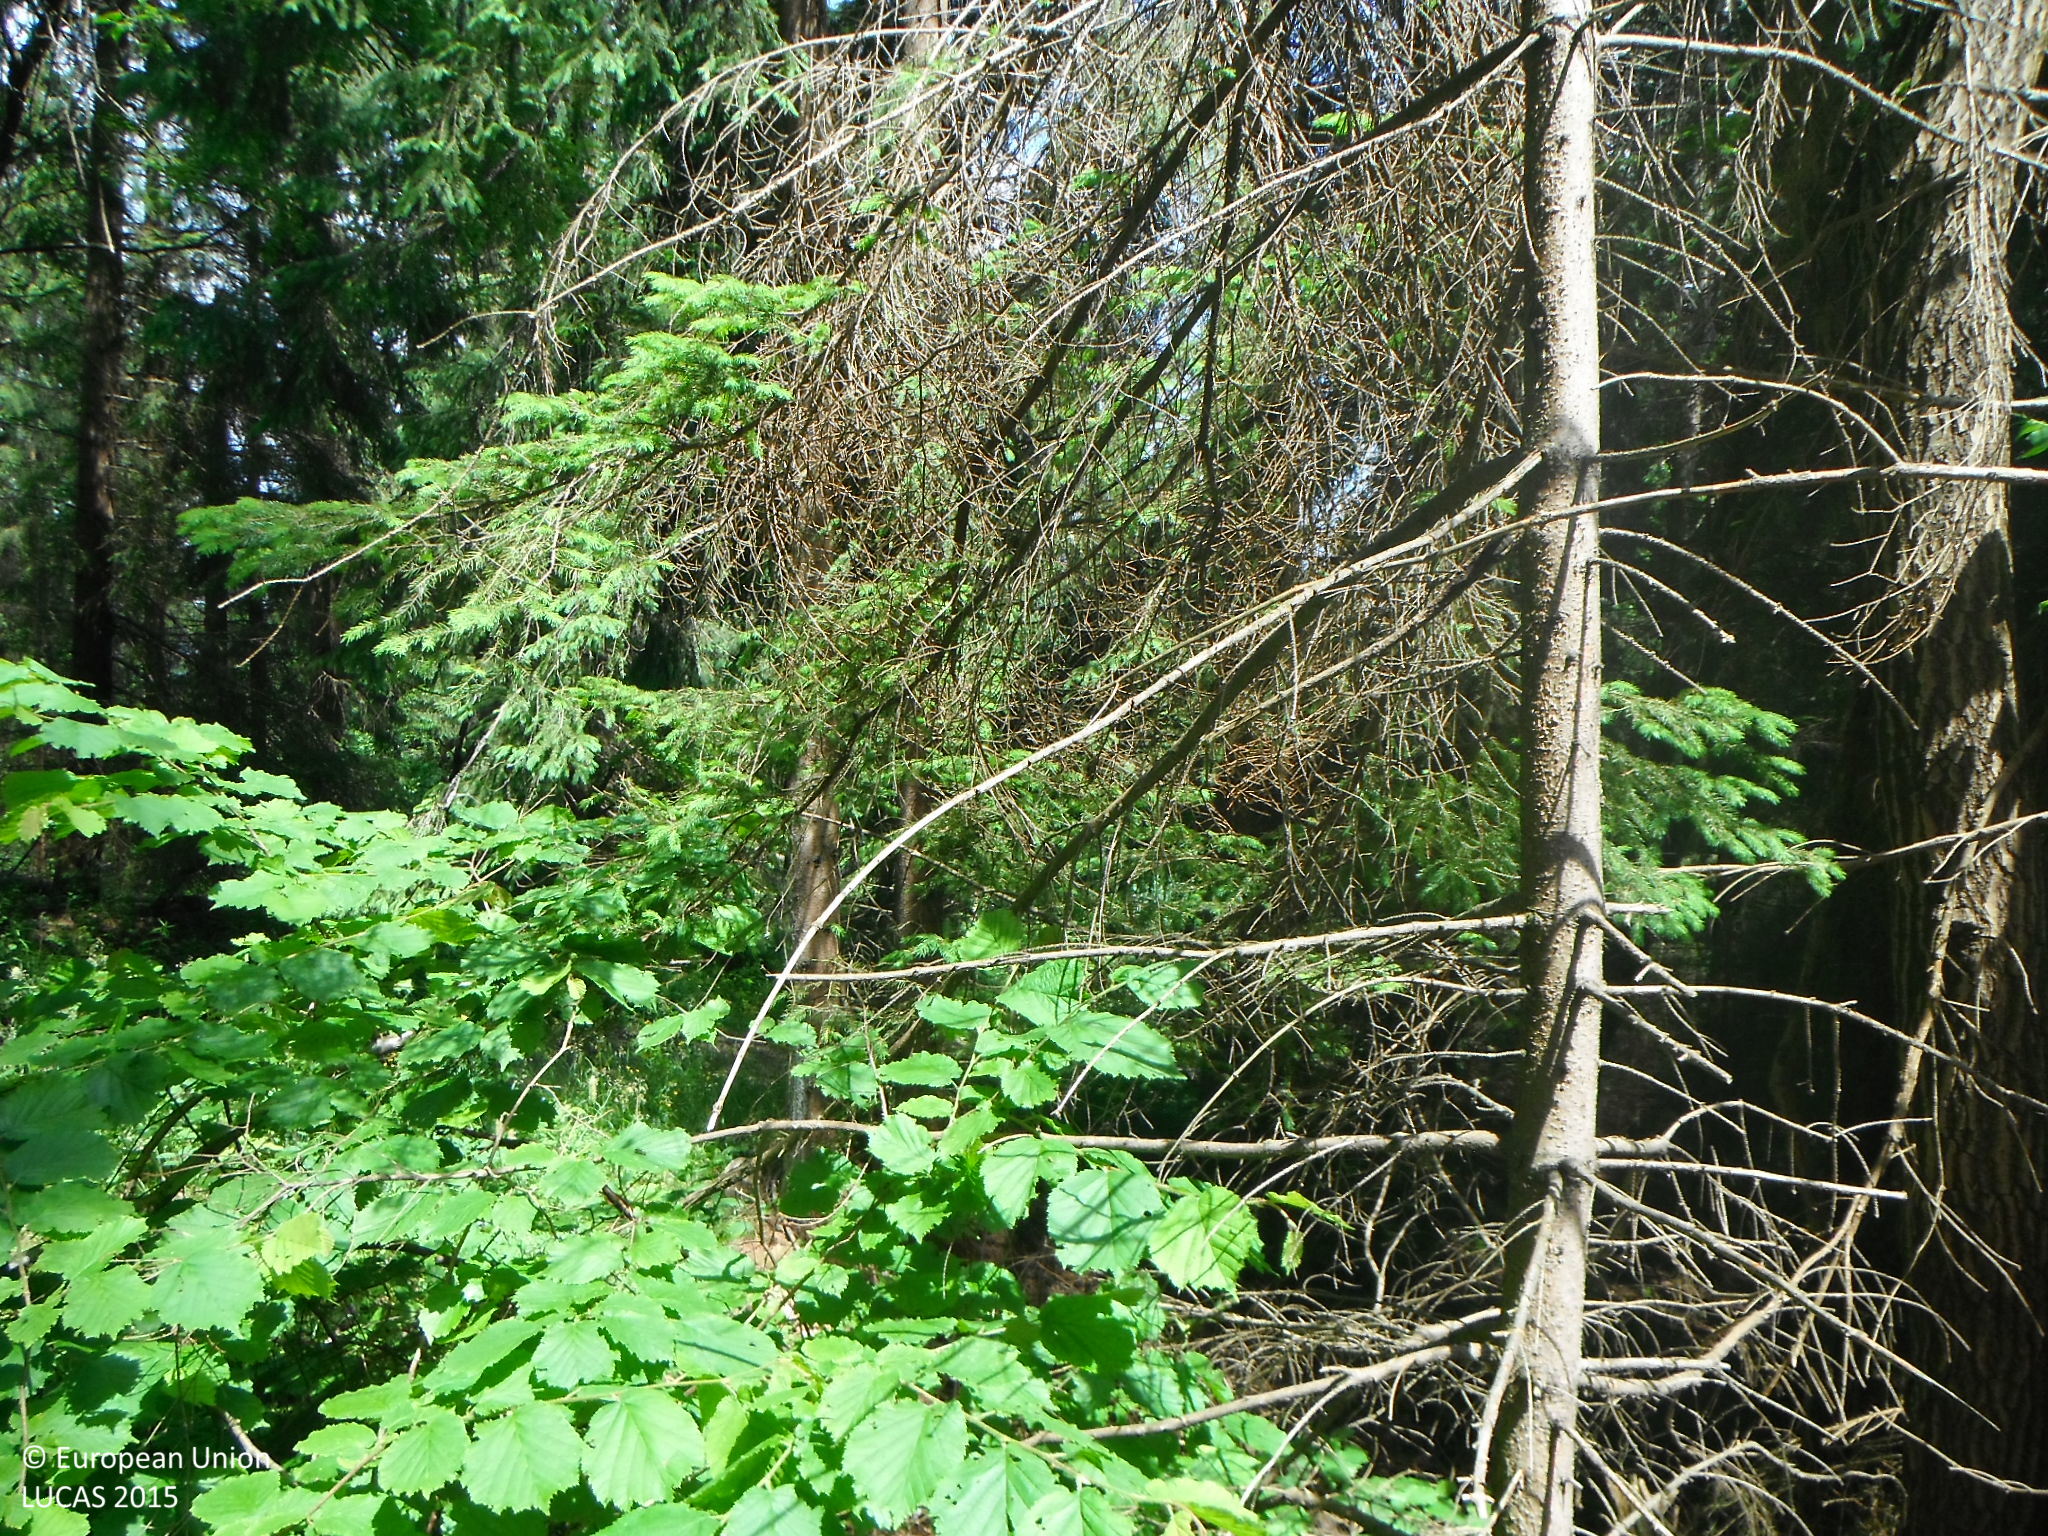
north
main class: Woodland
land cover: Spruce dominated mixed woodland
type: hemiboreal forest and nemoral coniferous forest and mixed broadleaved-coniferous forest
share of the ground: > 75 %
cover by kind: coniferous forest trees 65 %, broadleaved forest trees 25 %, herbaceous plants 10 %
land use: Forestry
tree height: > 5 m
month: June
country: SK
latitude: 49.2621
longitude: 19.4940
